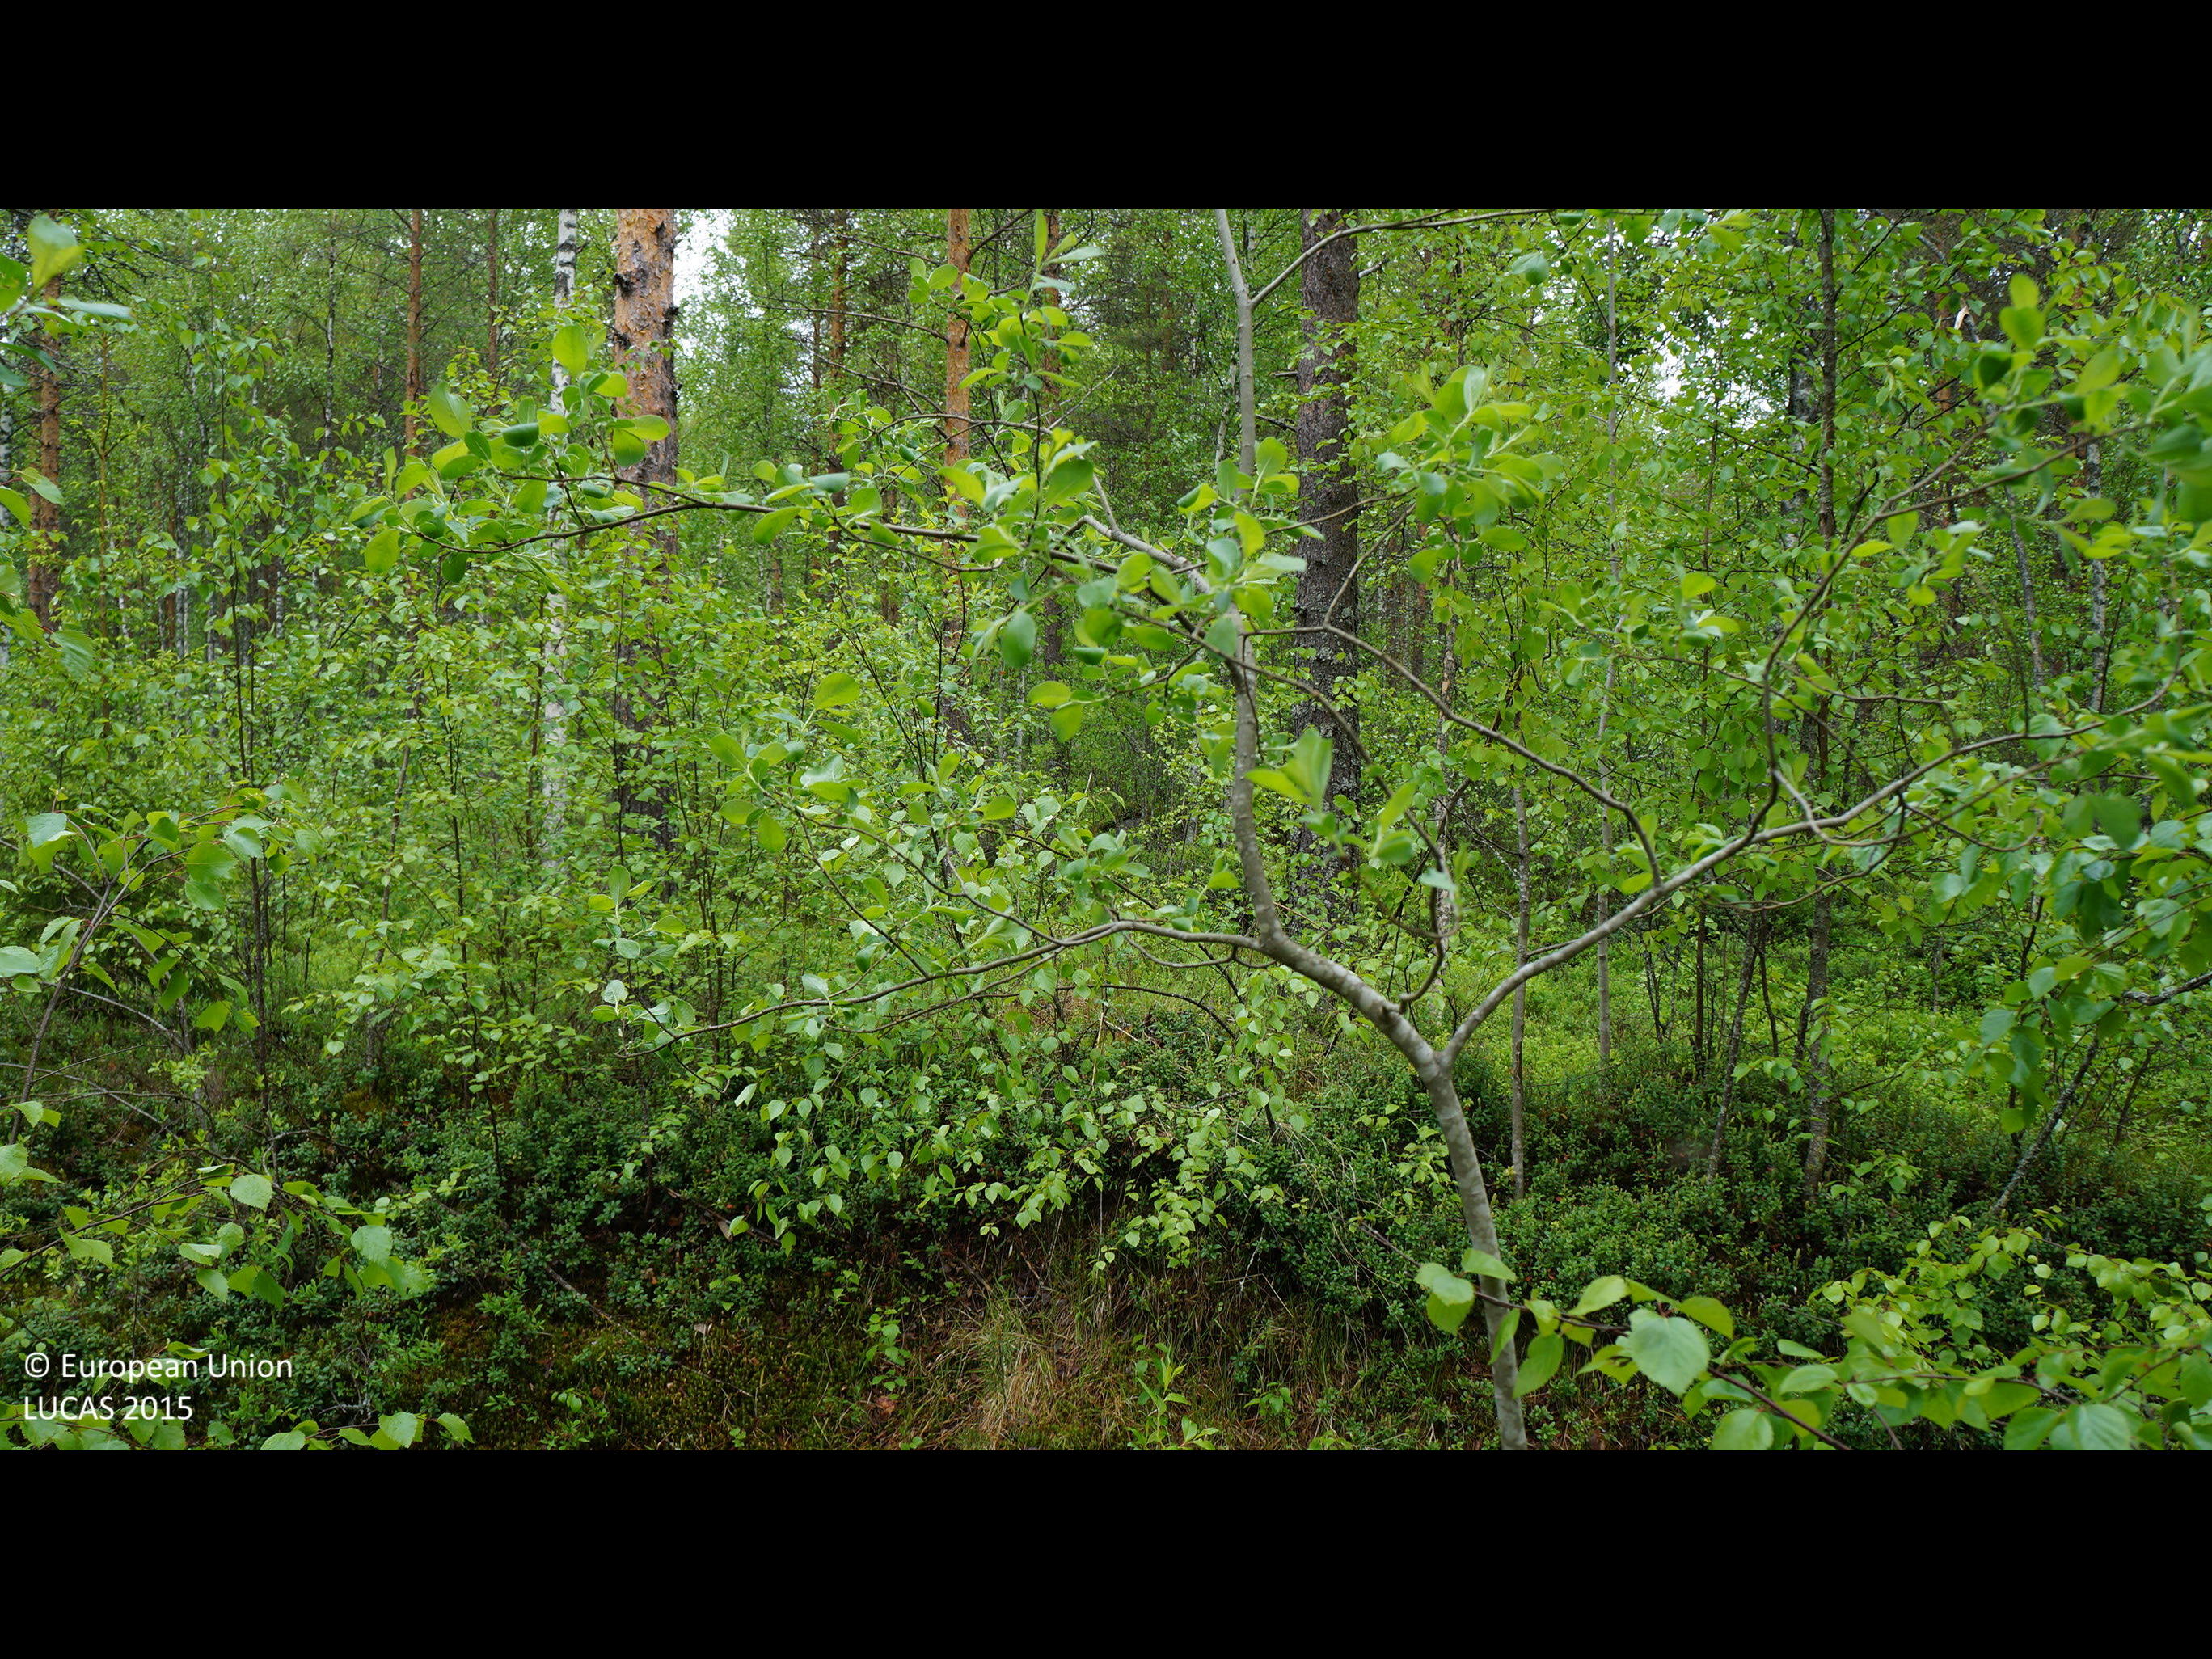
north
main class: Woodland
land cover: Pine dominated mixed woodland
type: boreal forest
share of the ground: 50 - 75 %
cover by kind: coniferous forest trees 50 %, broadleaved forest trees 20 %, shrubs 20 %, herbaceous plants 5 %, lichens and mosses 5 %
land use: Forestry
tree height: > 5 m
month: June
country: FI
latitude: 64.2693
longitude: 25.3879
